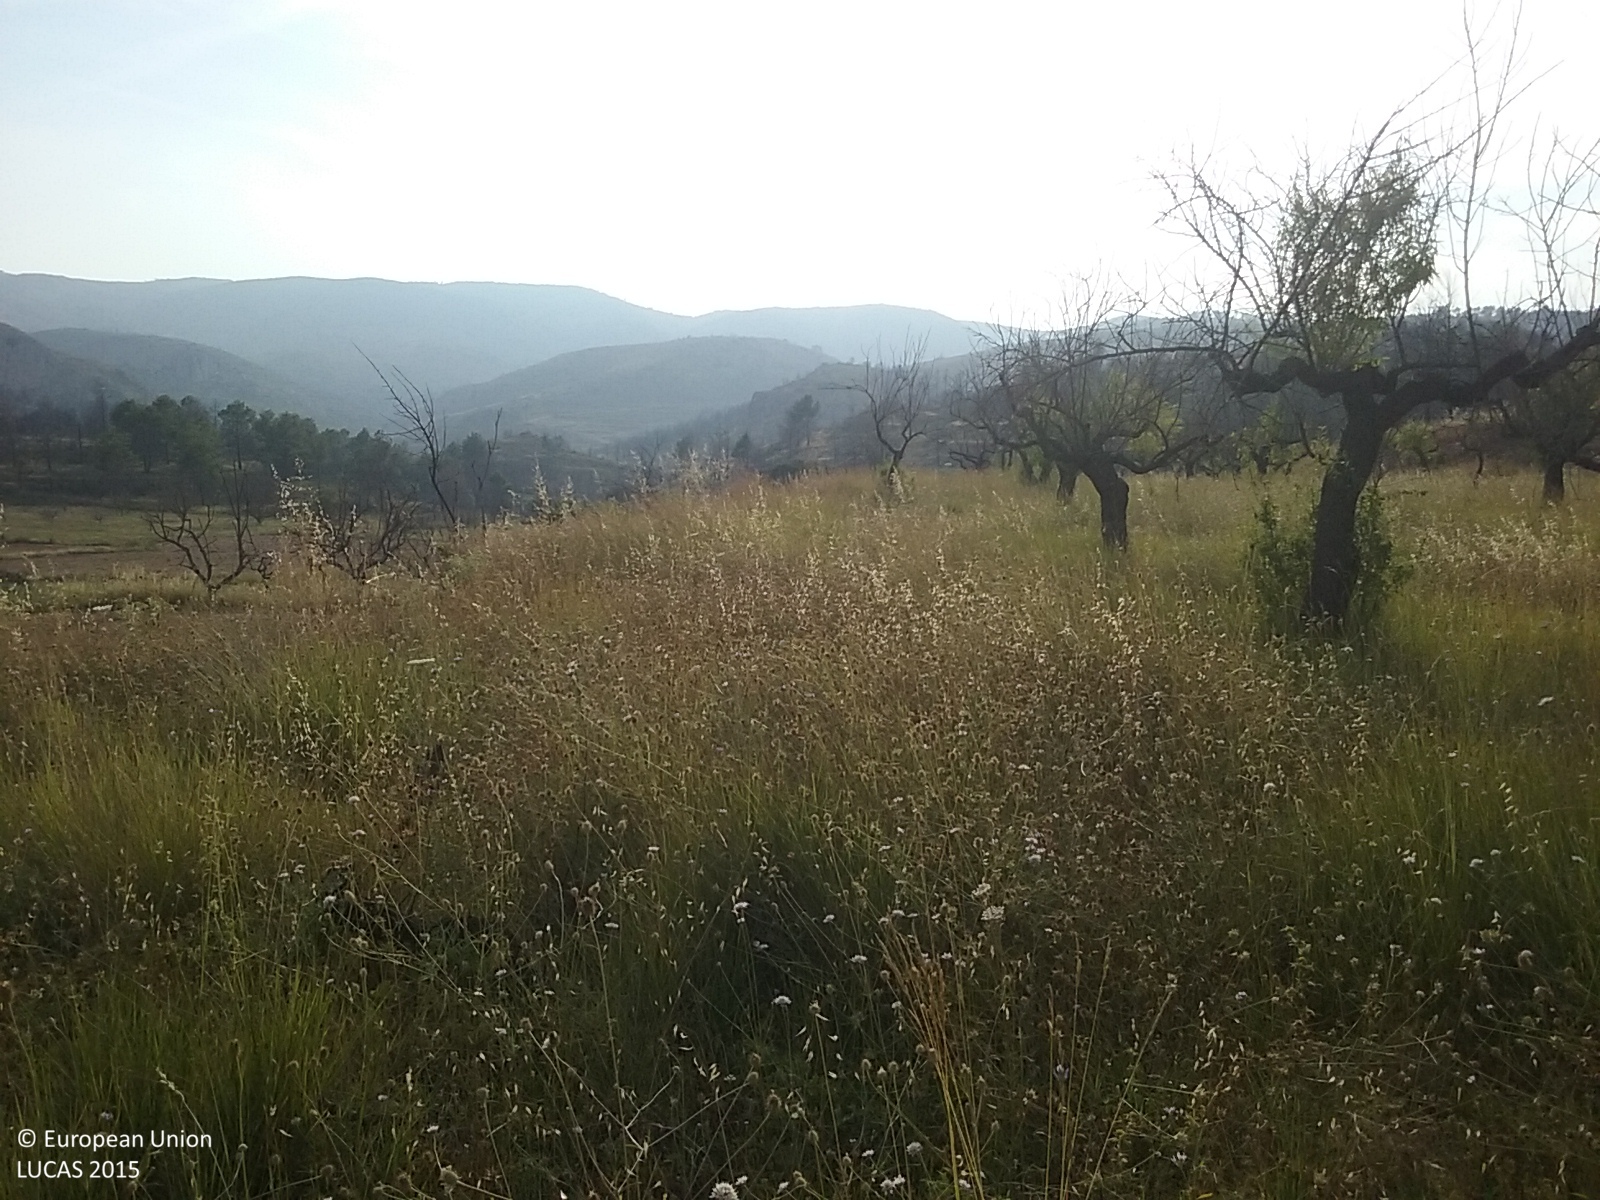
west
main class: Cropland
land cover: Nuts trees
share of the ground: < 10 %
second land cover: Grassland without tree/shrub cover
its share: > 75 %
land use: Abandoned areas
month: July
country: ES
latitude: 39.8833
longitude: -0.6792
